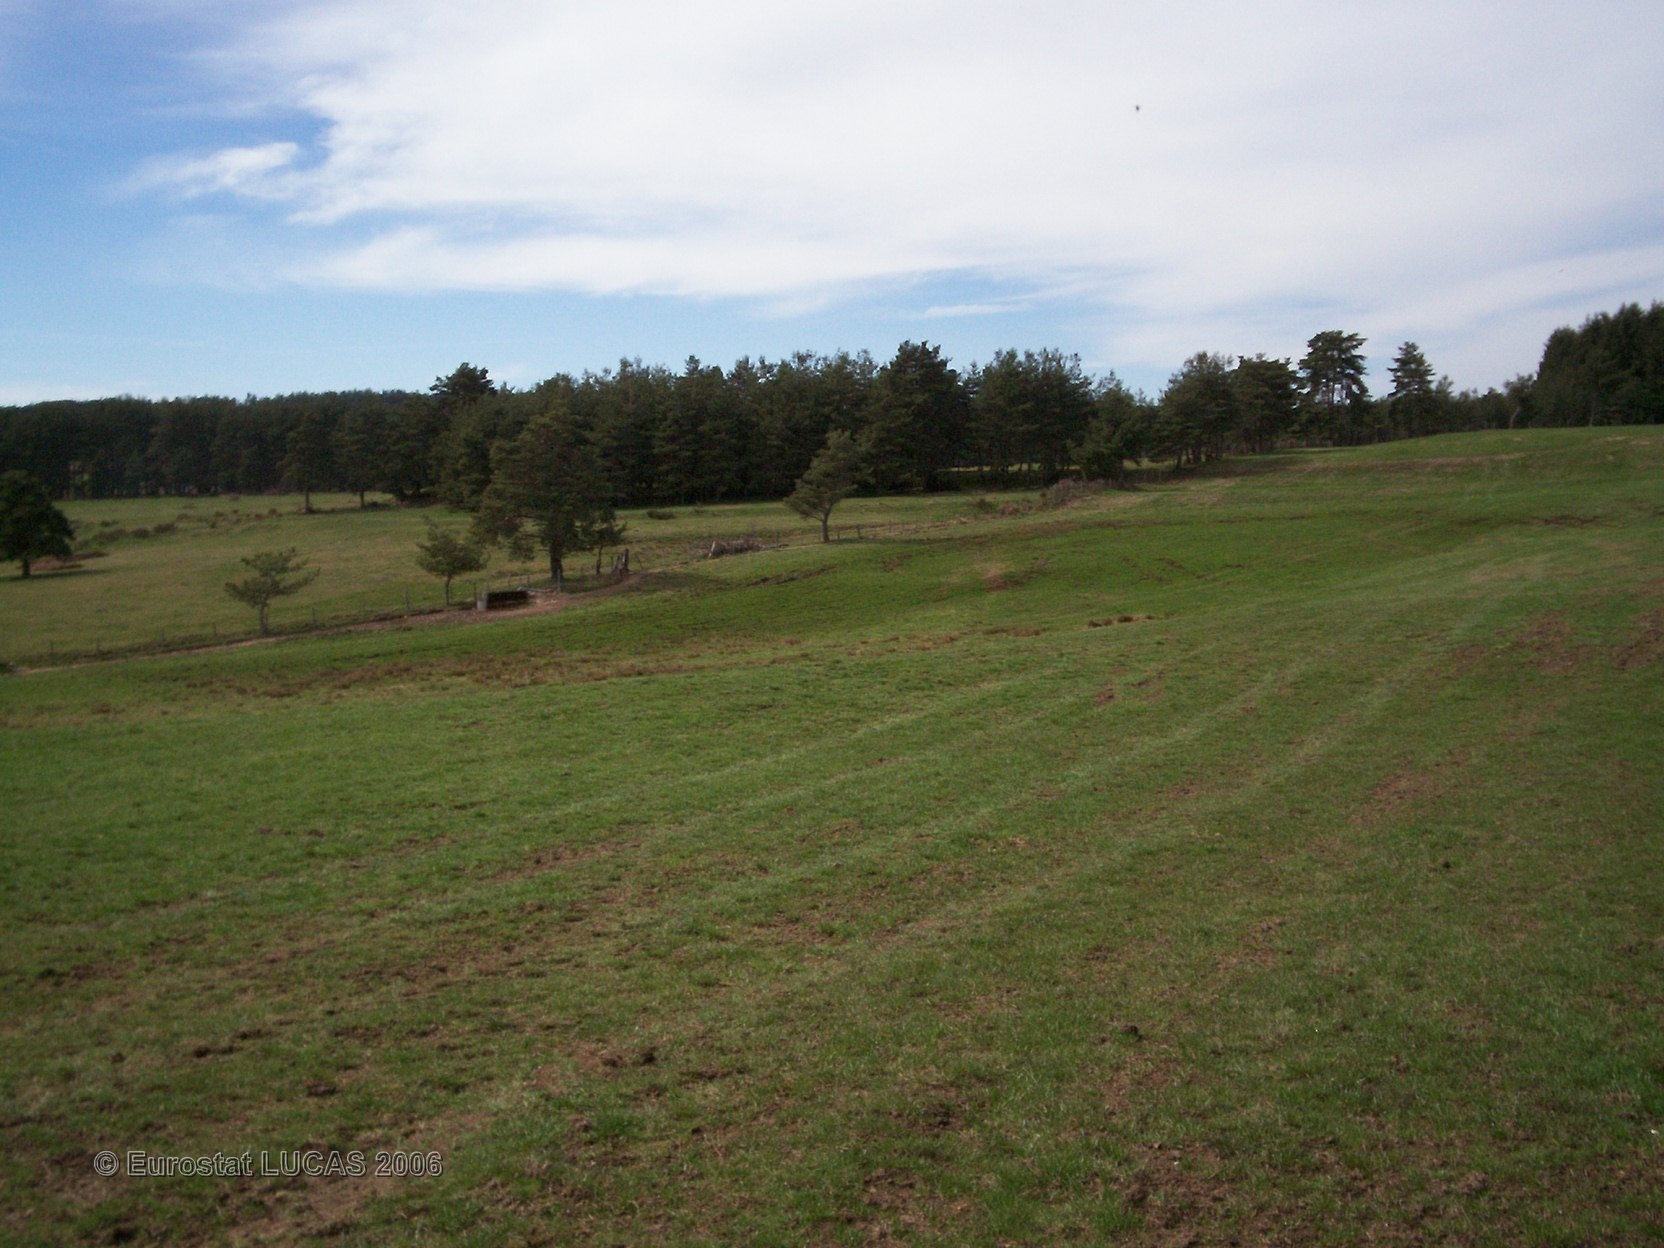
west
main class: Grassland
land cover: Grassland without tree/shrub cover
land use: Agriculture (excluding fallow land and kitchen gardens)
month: April
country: FR
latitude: 44.8206
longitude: 3.2883
